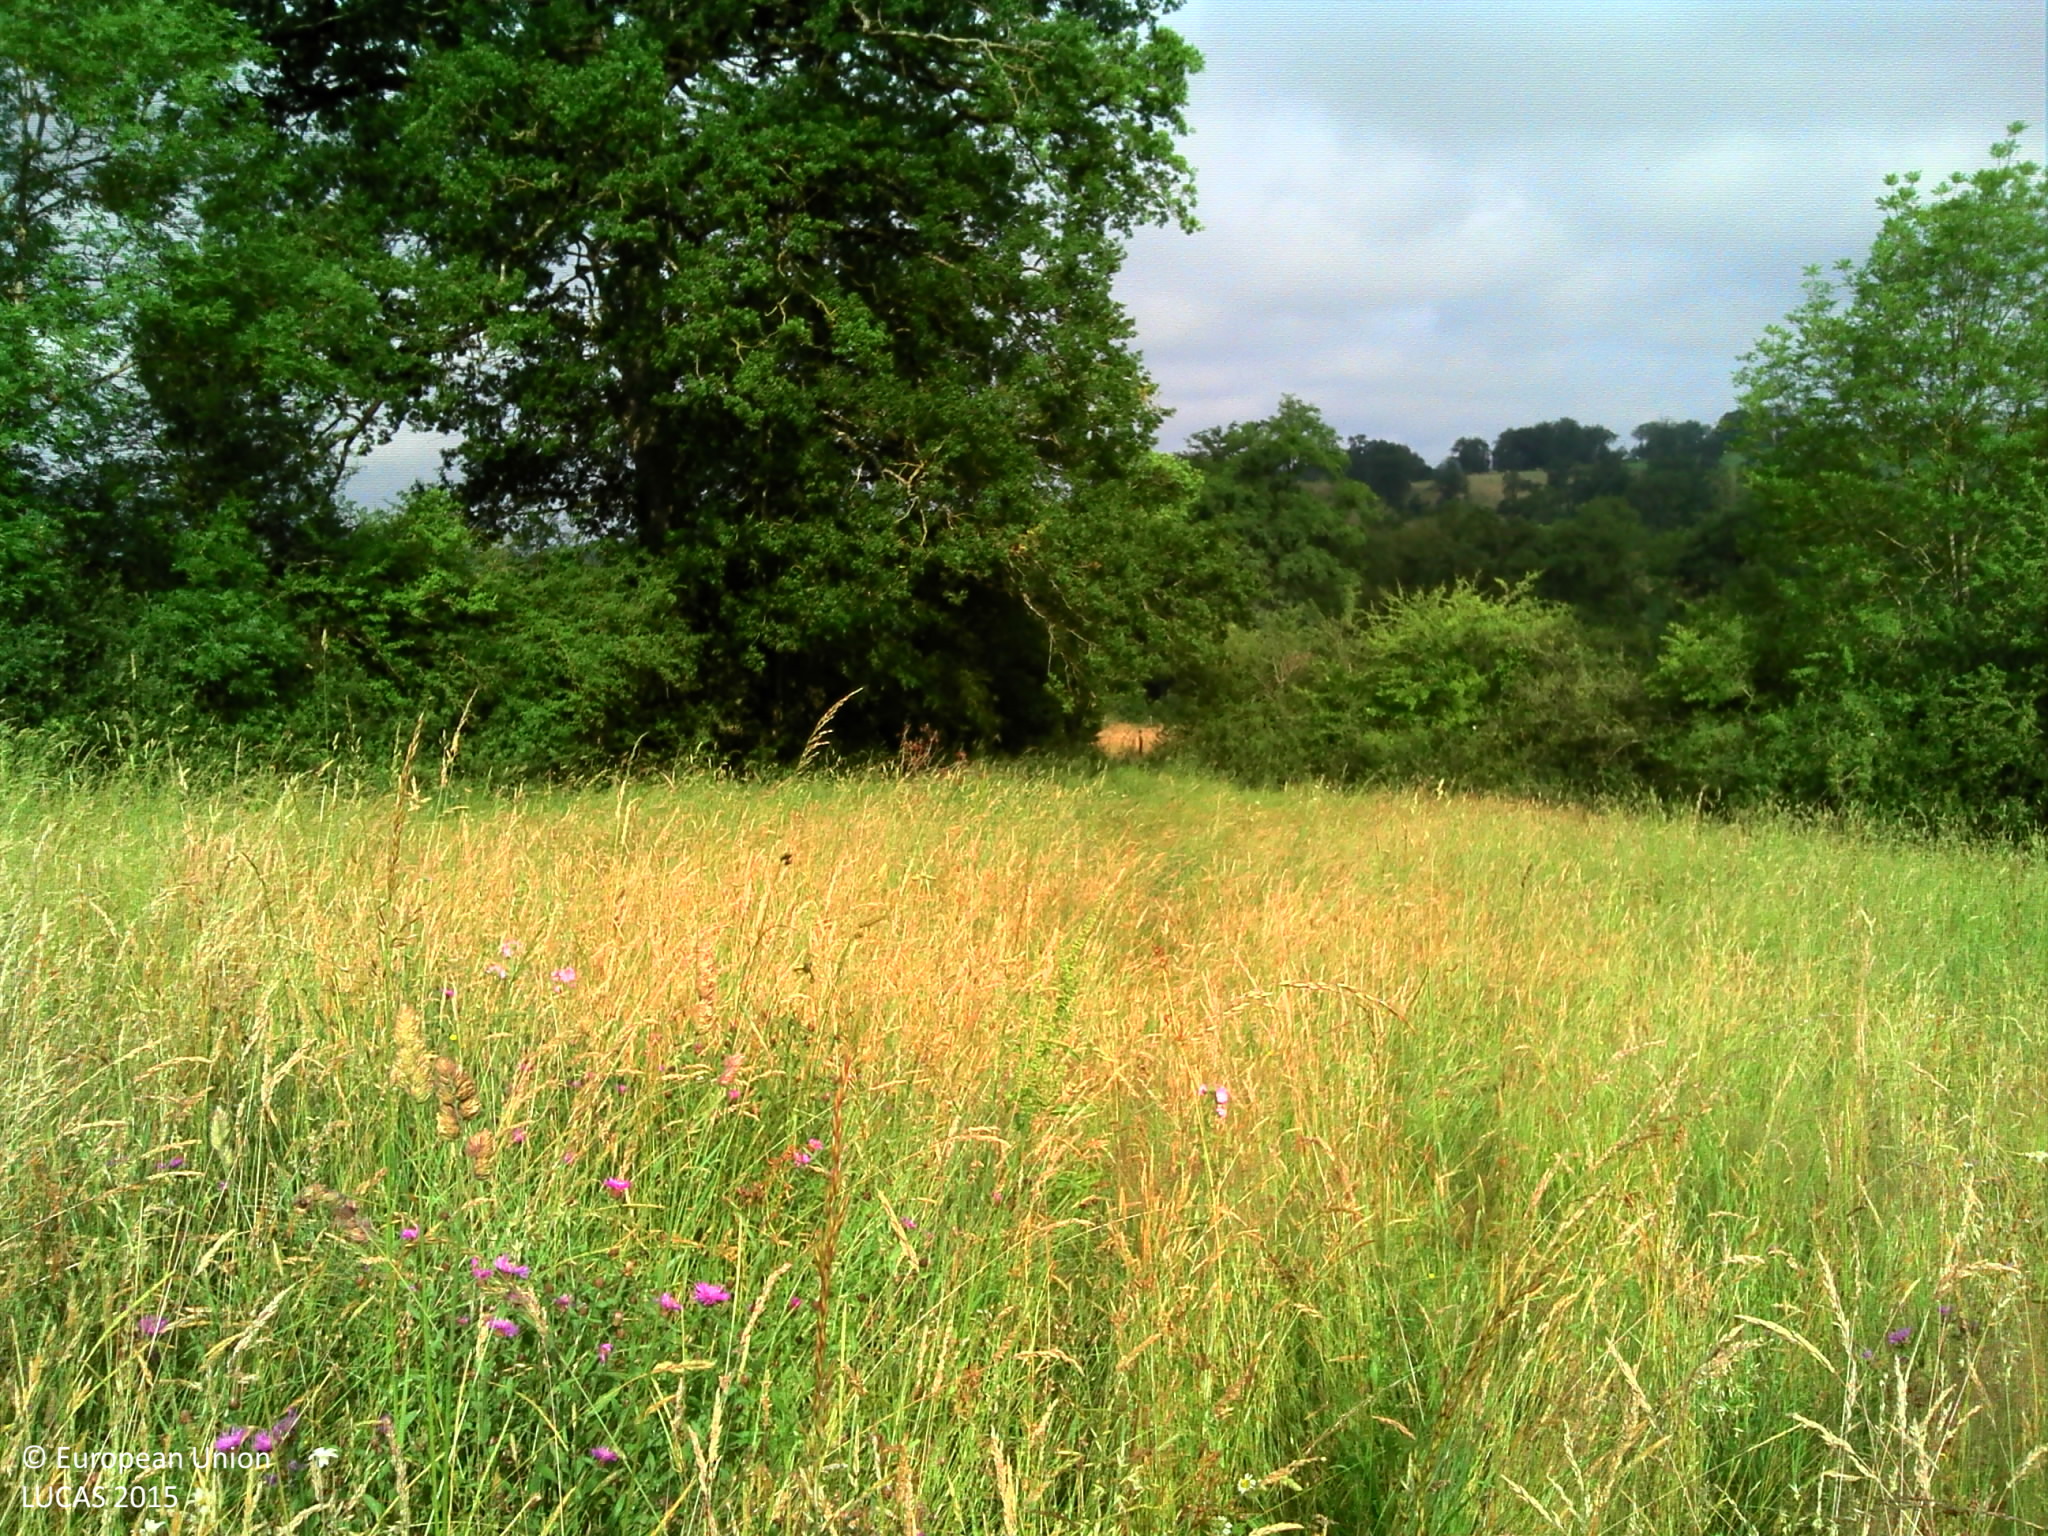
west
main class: Grassland
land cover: Grassland without tree/shrub cover
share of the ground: > 75 %
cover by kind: herbaceous plants 100 %
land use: Agriculture (excluding fallow land and kitchen gardens)
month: June
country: FR
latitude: 44.2087
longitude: 2.0552
